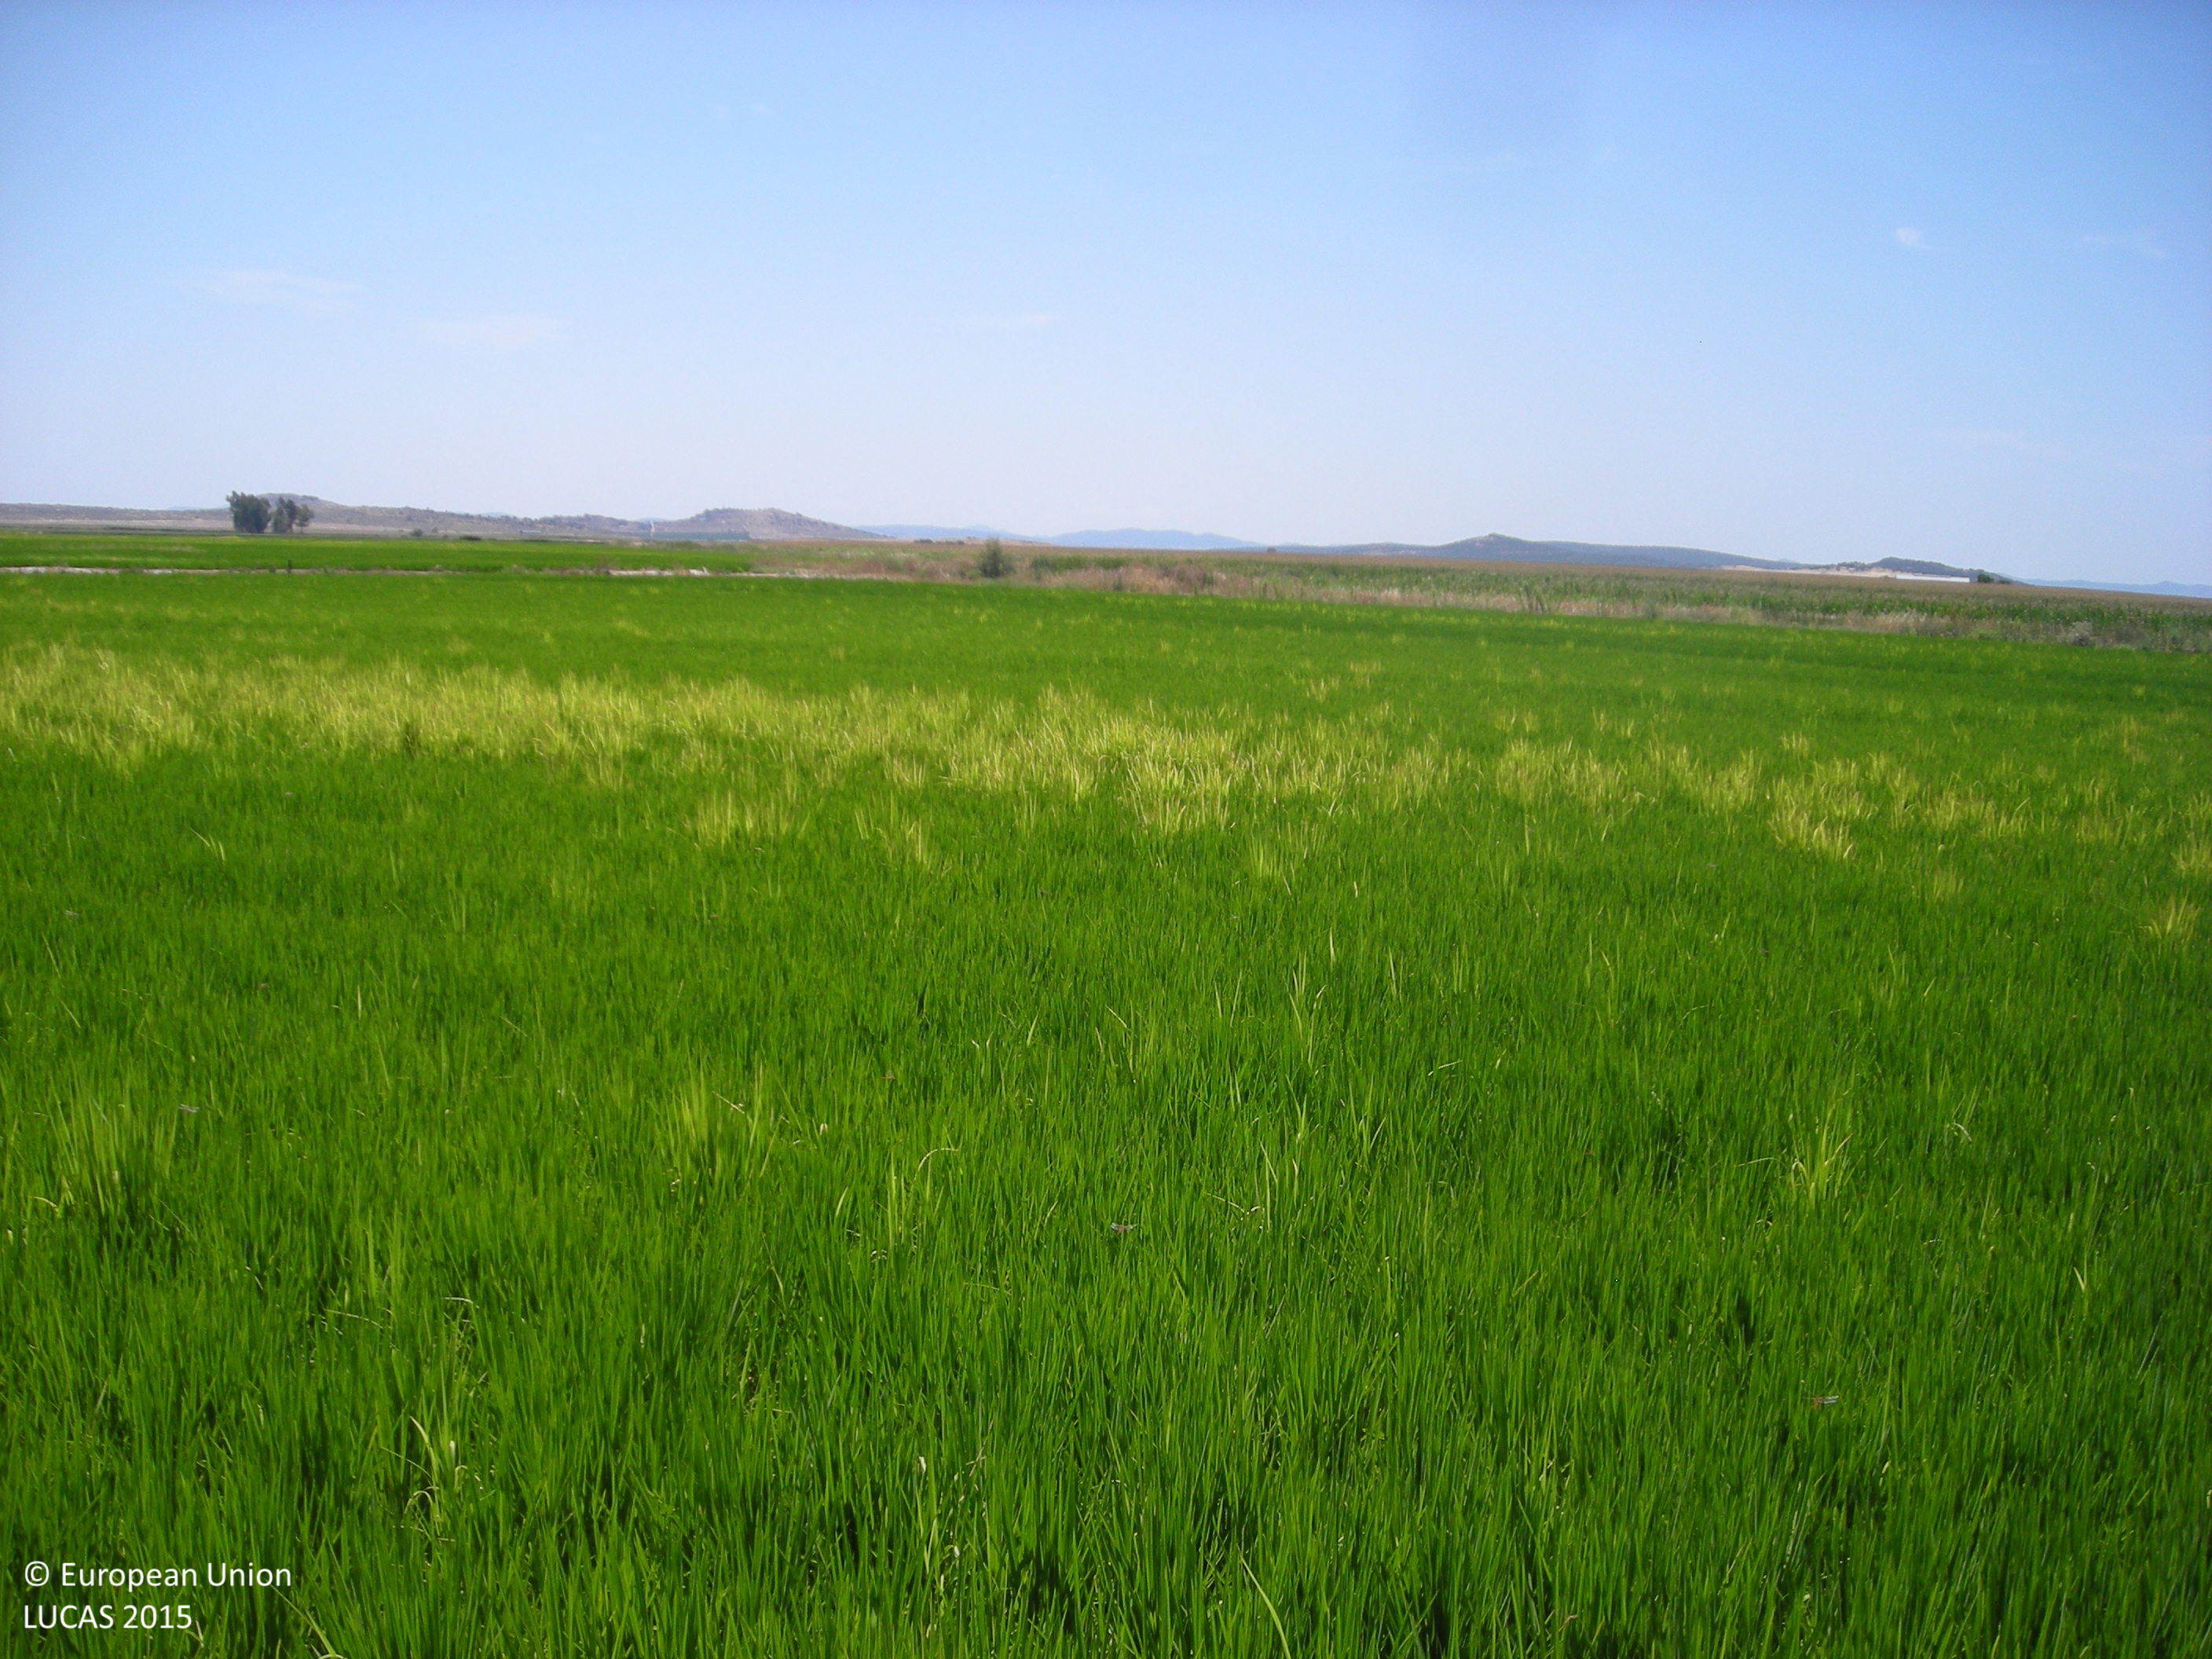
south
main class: Cropland
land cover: Maize
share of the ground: > 75 %
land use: Agriculture (excluding fallow land and kitchen gardens)
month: July
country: ES
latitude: 39.0430
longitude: -5.9621
